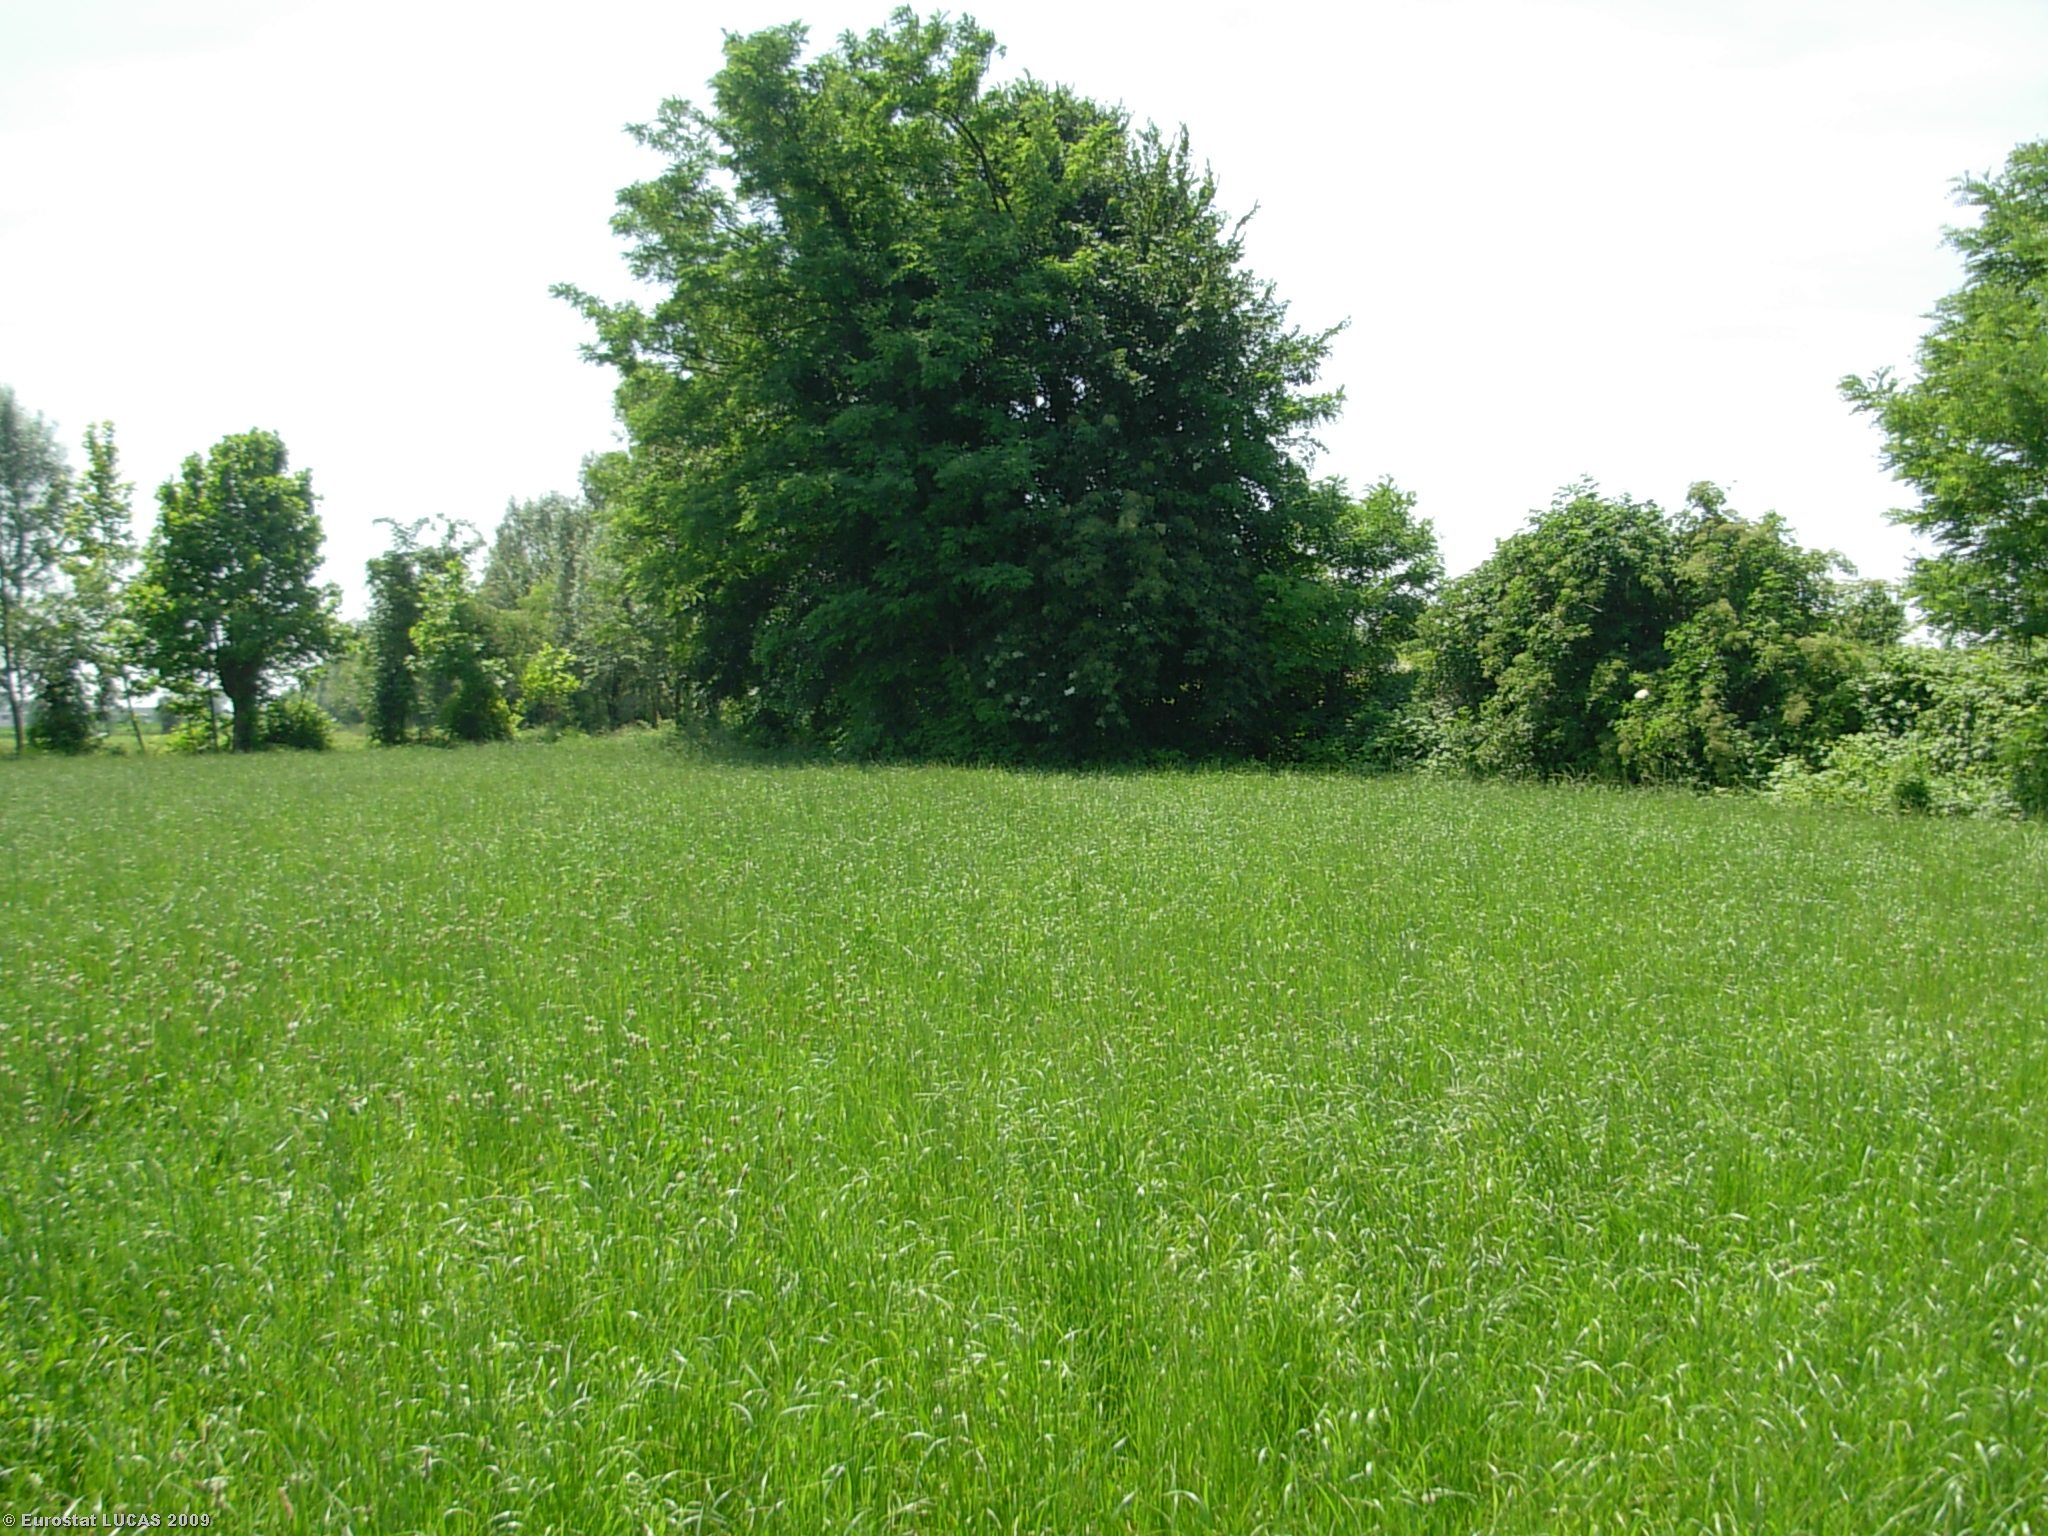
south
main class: Grassland
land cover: Grassland without tree/shrub cover
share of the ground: > 75 %
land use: Agriculture (excluding fallow land and kitchen gardens)
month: June
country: IT
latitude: 45.3597
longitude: 10.3441
